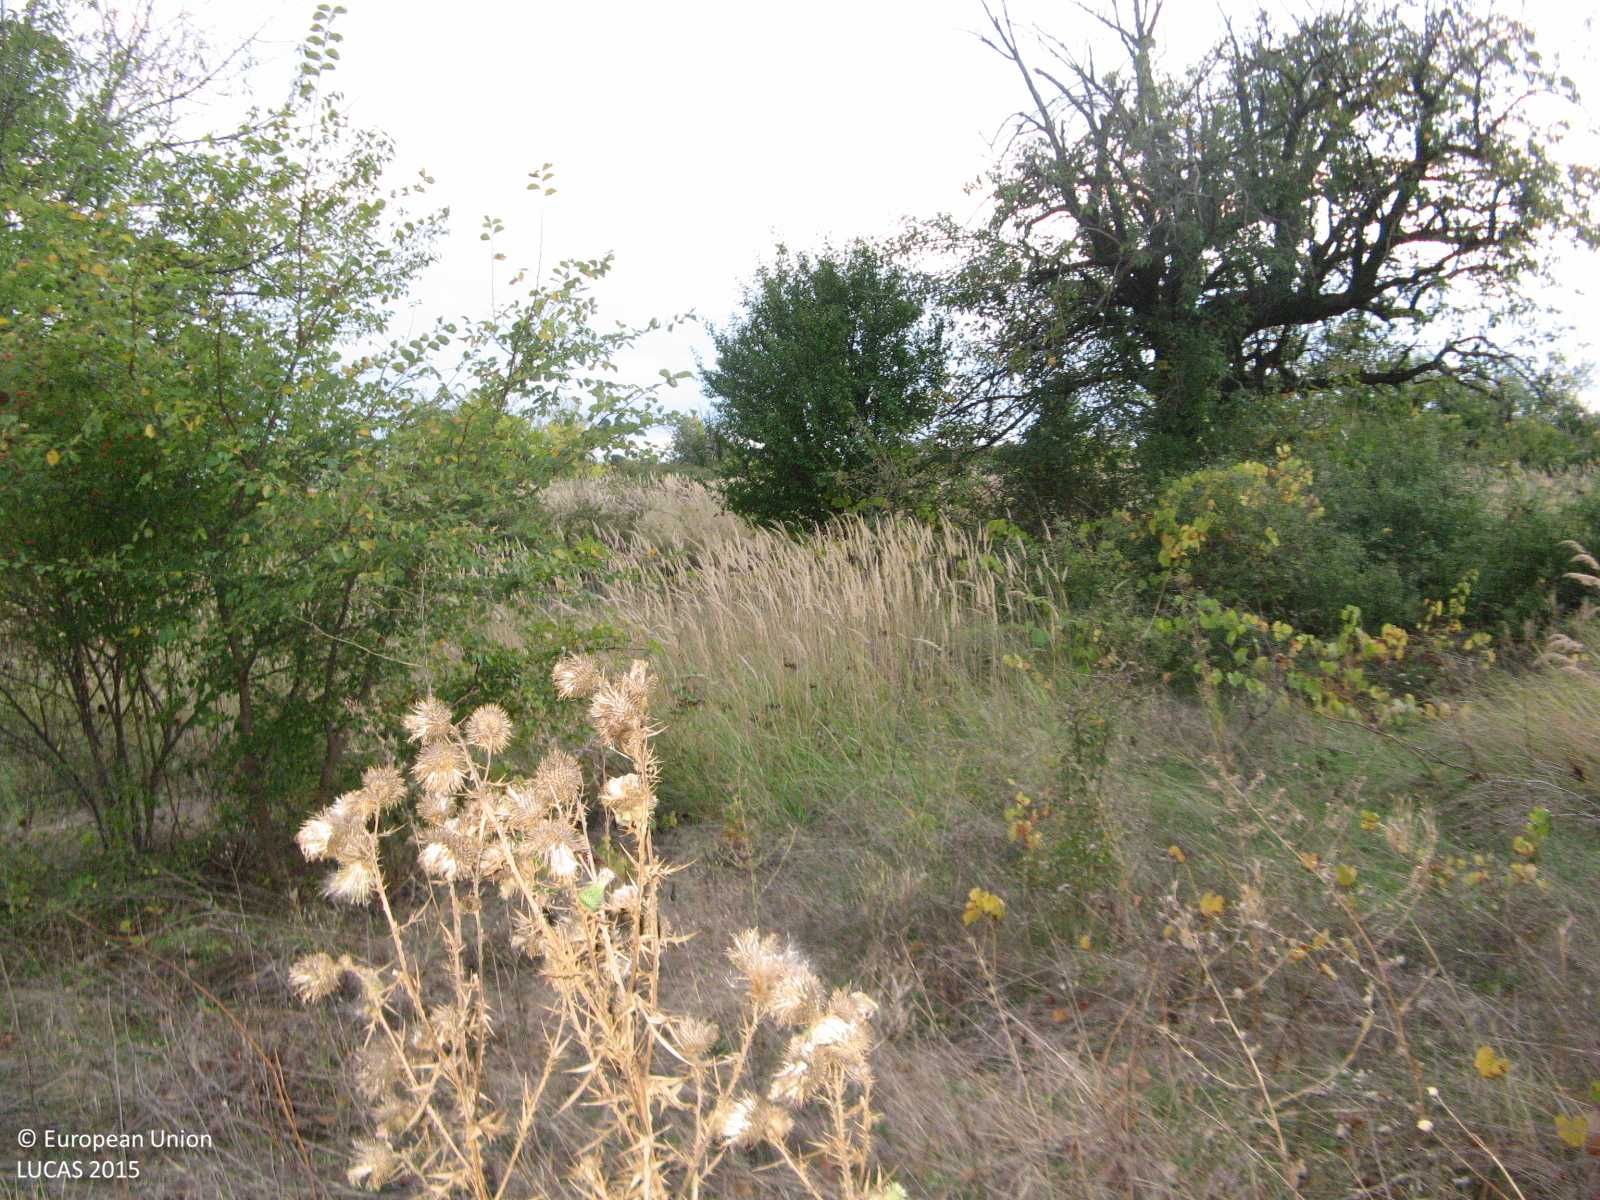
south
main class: Grassland
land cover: Grassland with sparse tree/shrub cover
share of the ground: > 75 %
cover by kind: herbaceous plants 85 %, shrubs 10 %, broadleaved forest trees 5 %
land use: Fallow land
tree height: > 5 m
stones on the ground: < 10 %
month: October
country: BG
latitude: 41.9537
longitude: 25.3455
